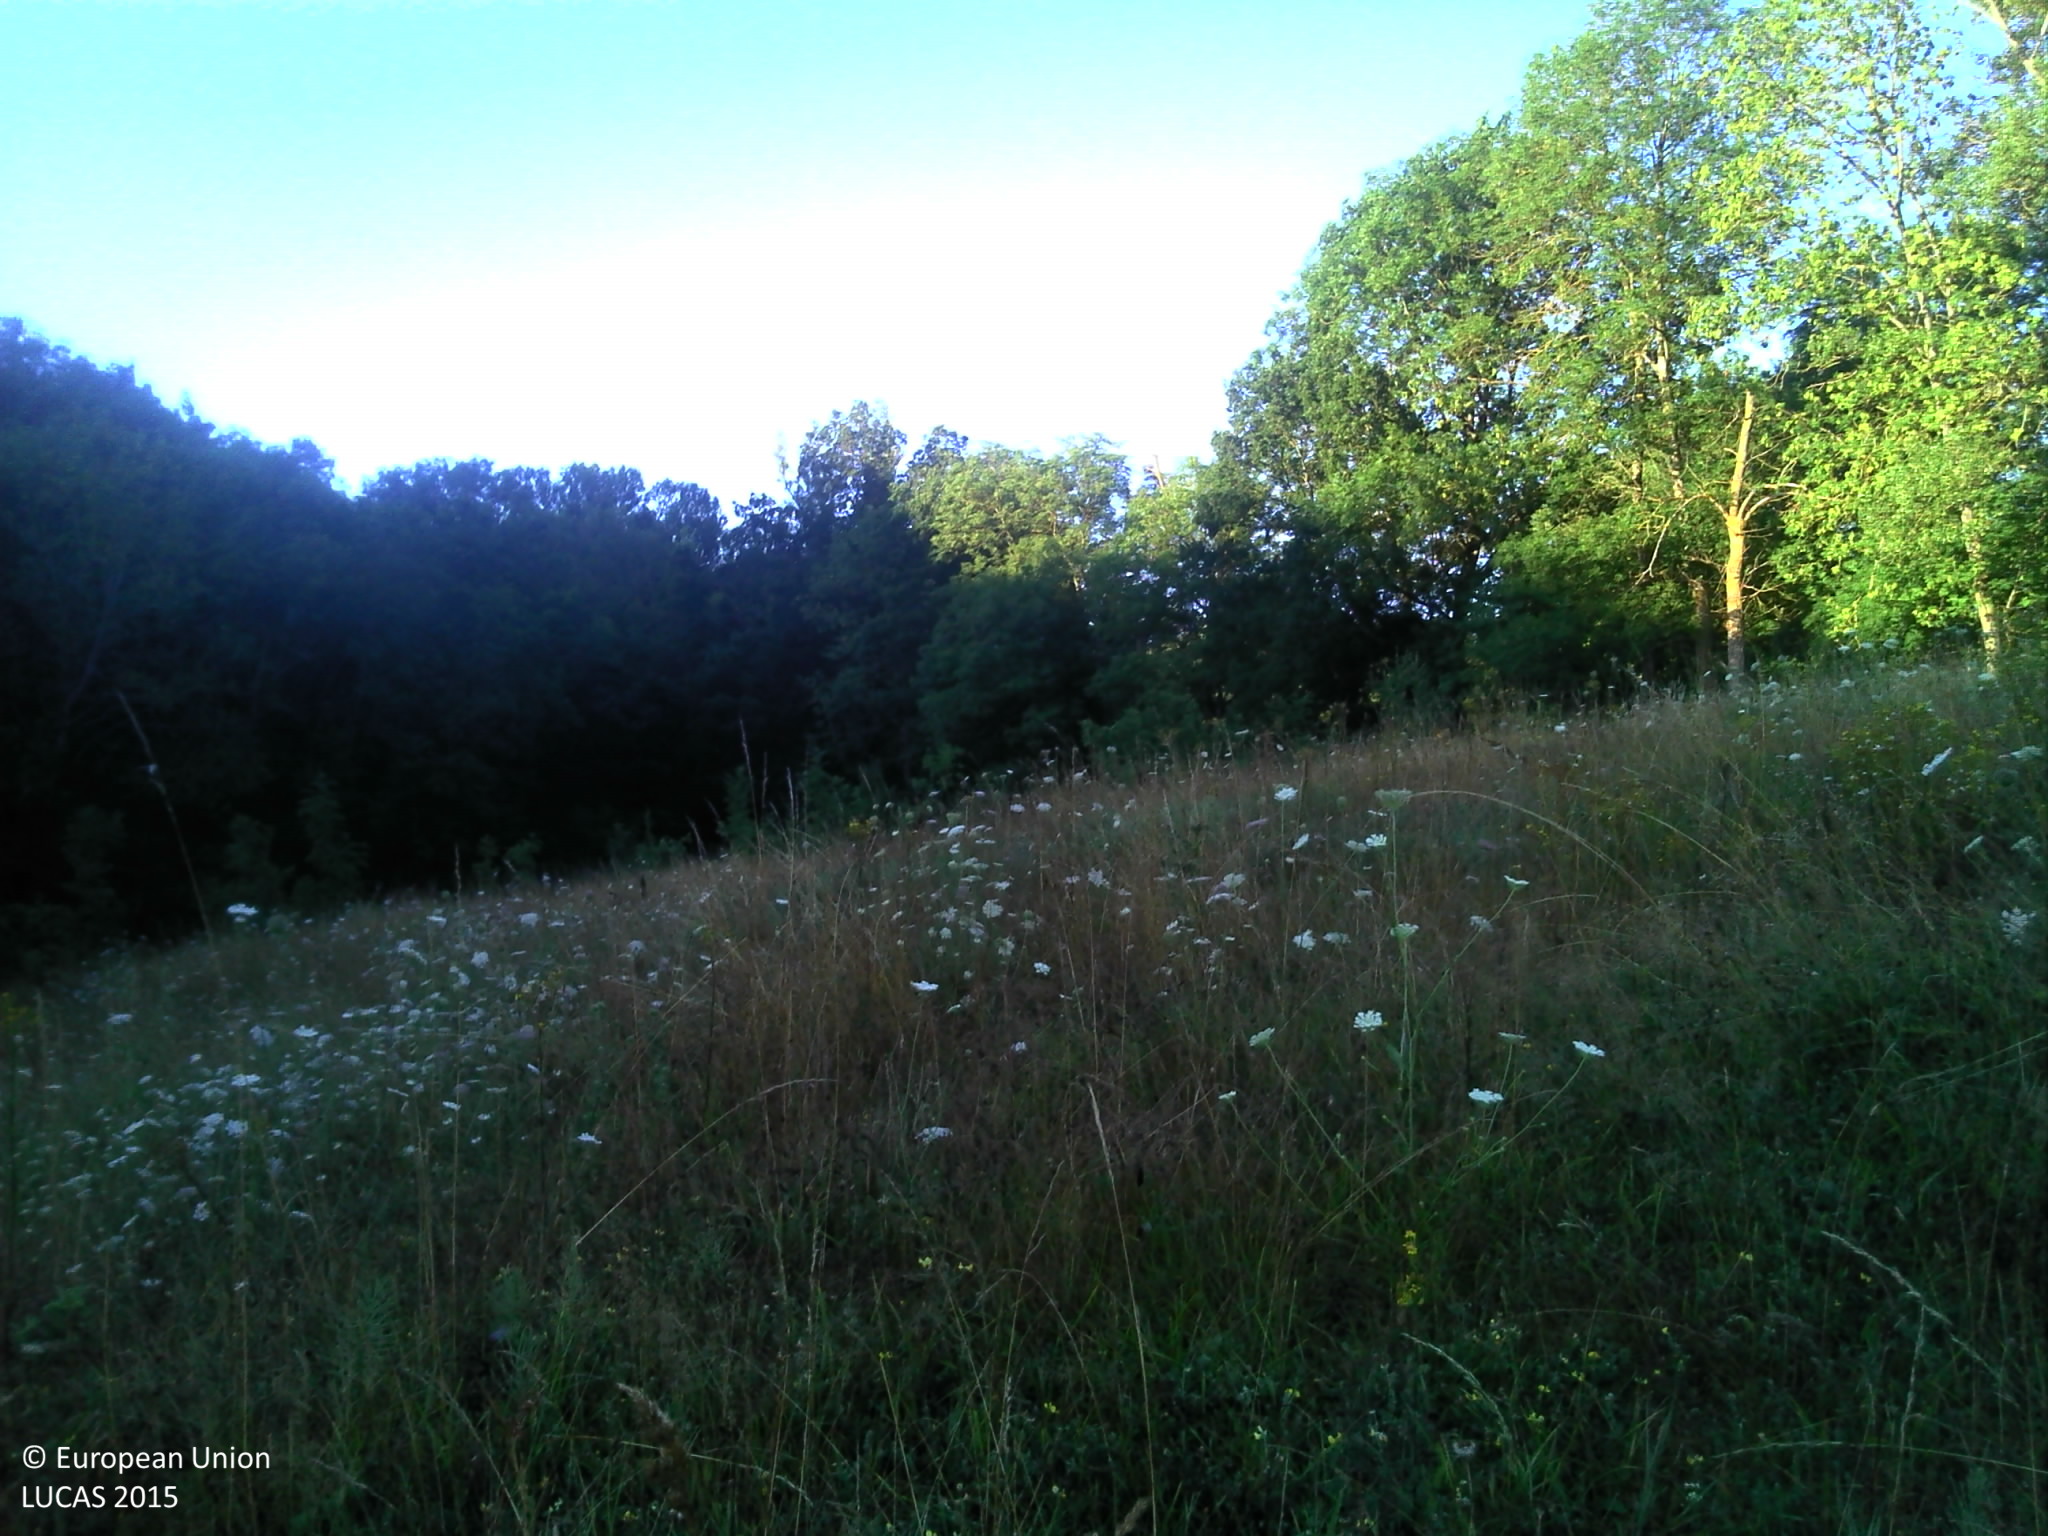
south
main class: Grassland
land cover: Grassland without tree/shrub cover
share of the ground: > 75 %
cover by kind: herbaceous plants 100 %
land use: Agriculture (excluding fallow land and kitchen gardens)
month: July
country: FR
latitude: 45.0523
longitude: 3.8203
